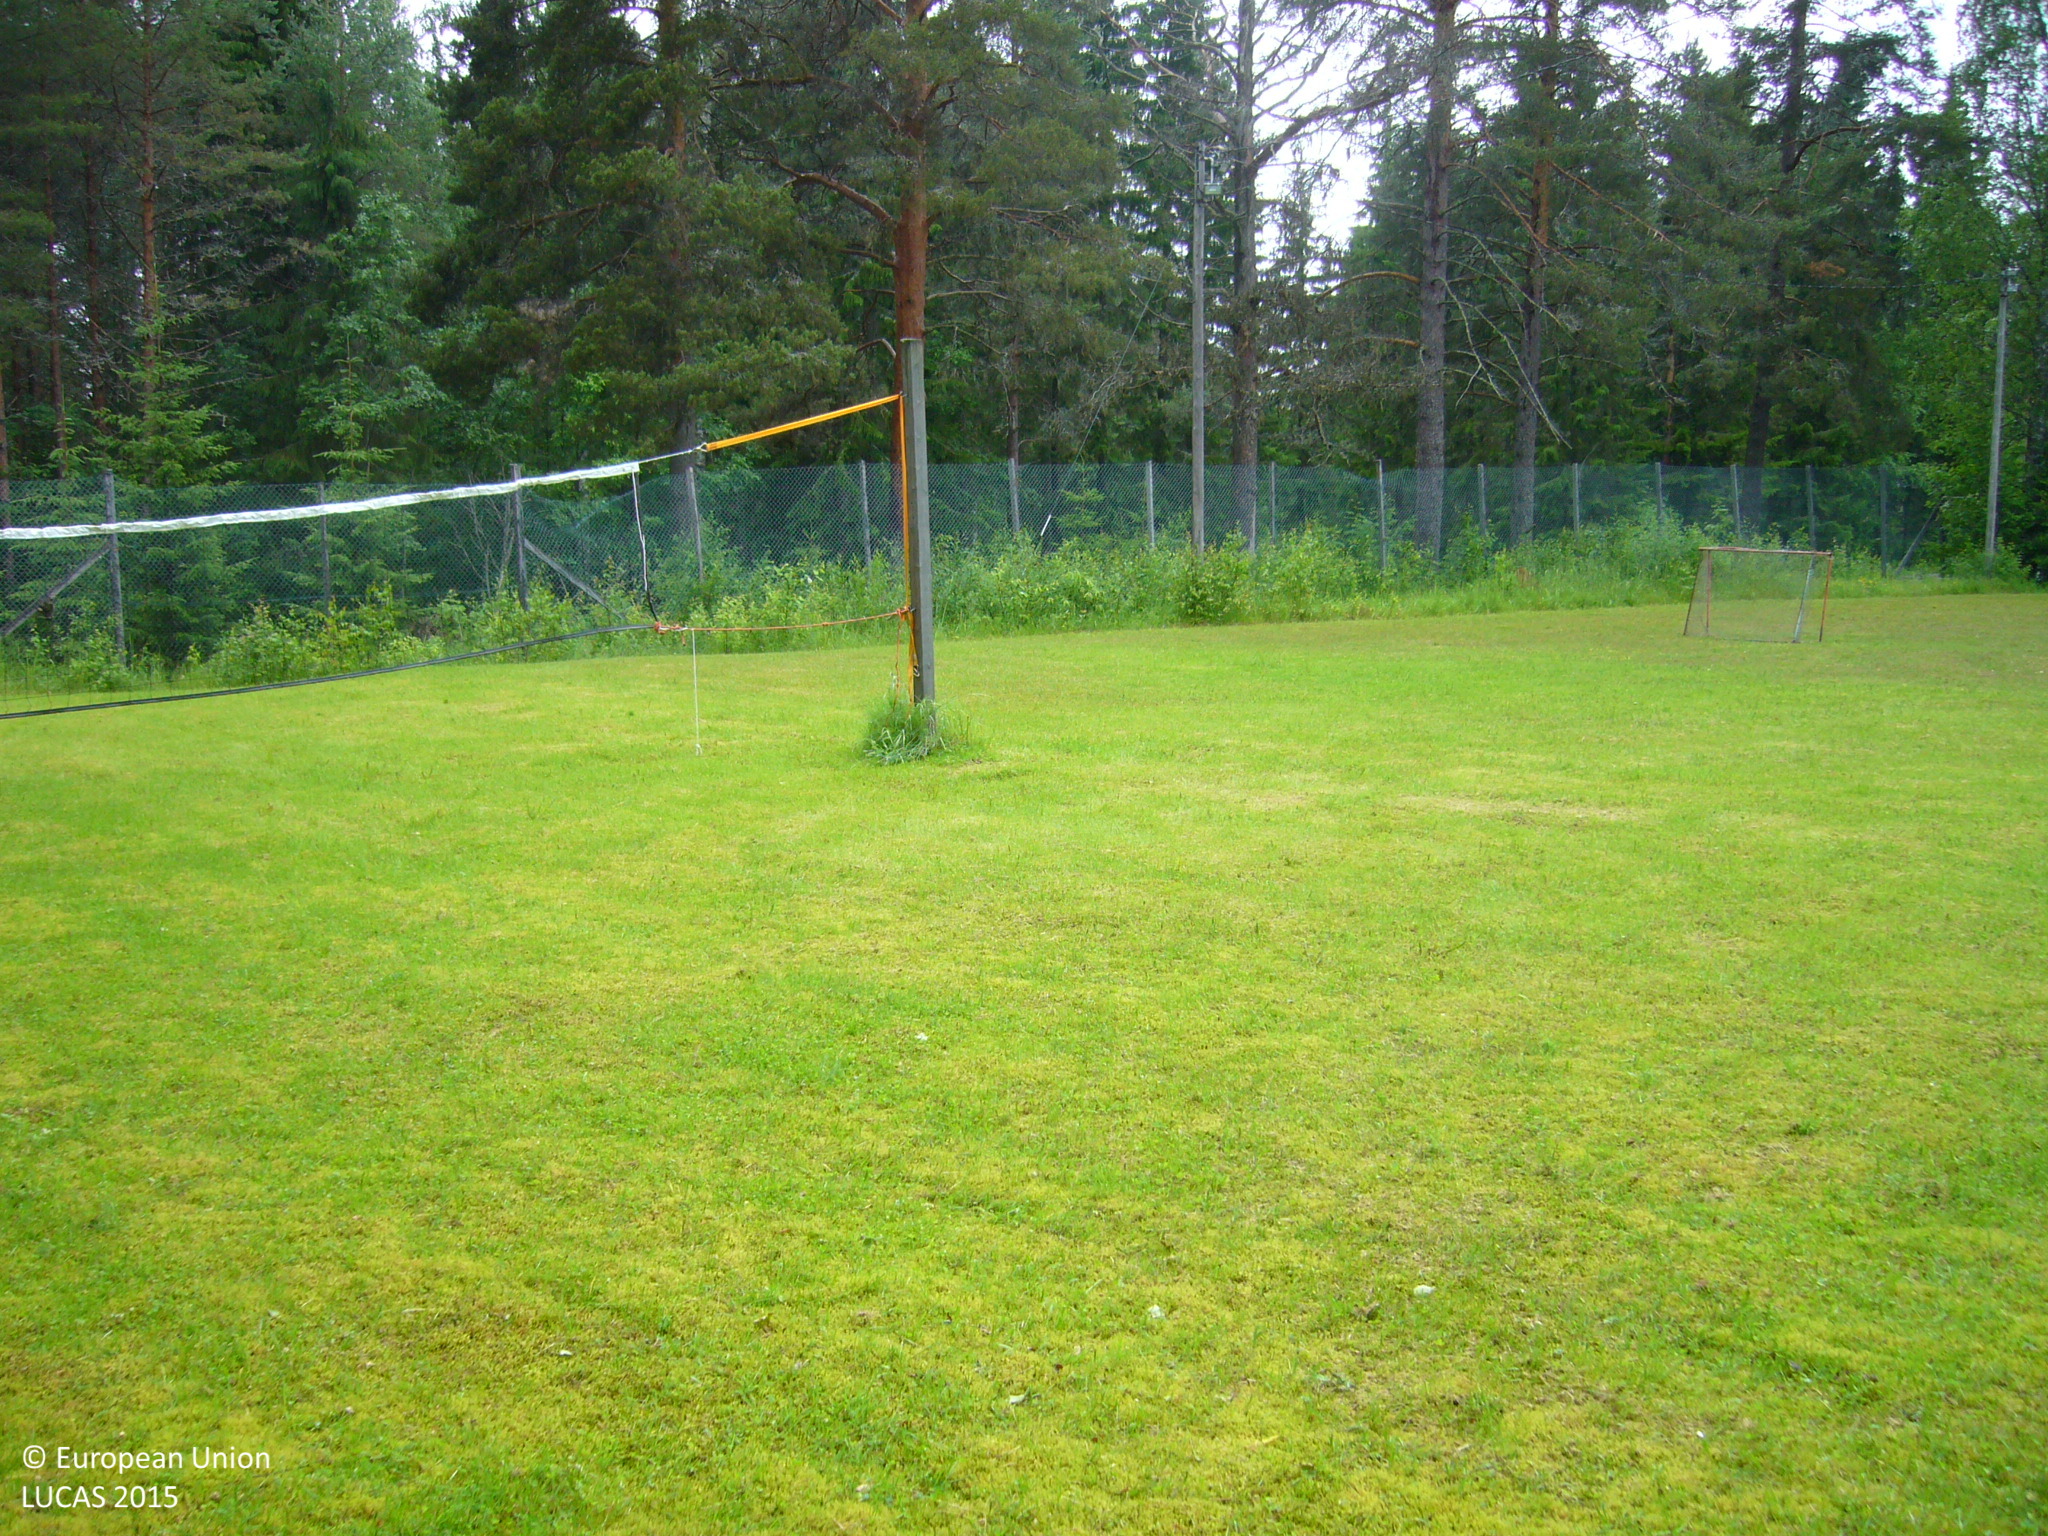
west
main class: Grassland
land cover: Grassland with sparse tree/shrub cover
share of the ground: > 75 %
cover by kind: herbaceous plants 95 %, broadleaved forest trees 5 %
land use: Community services
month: July
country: FI
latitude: 63.4040
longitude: 25.5393
